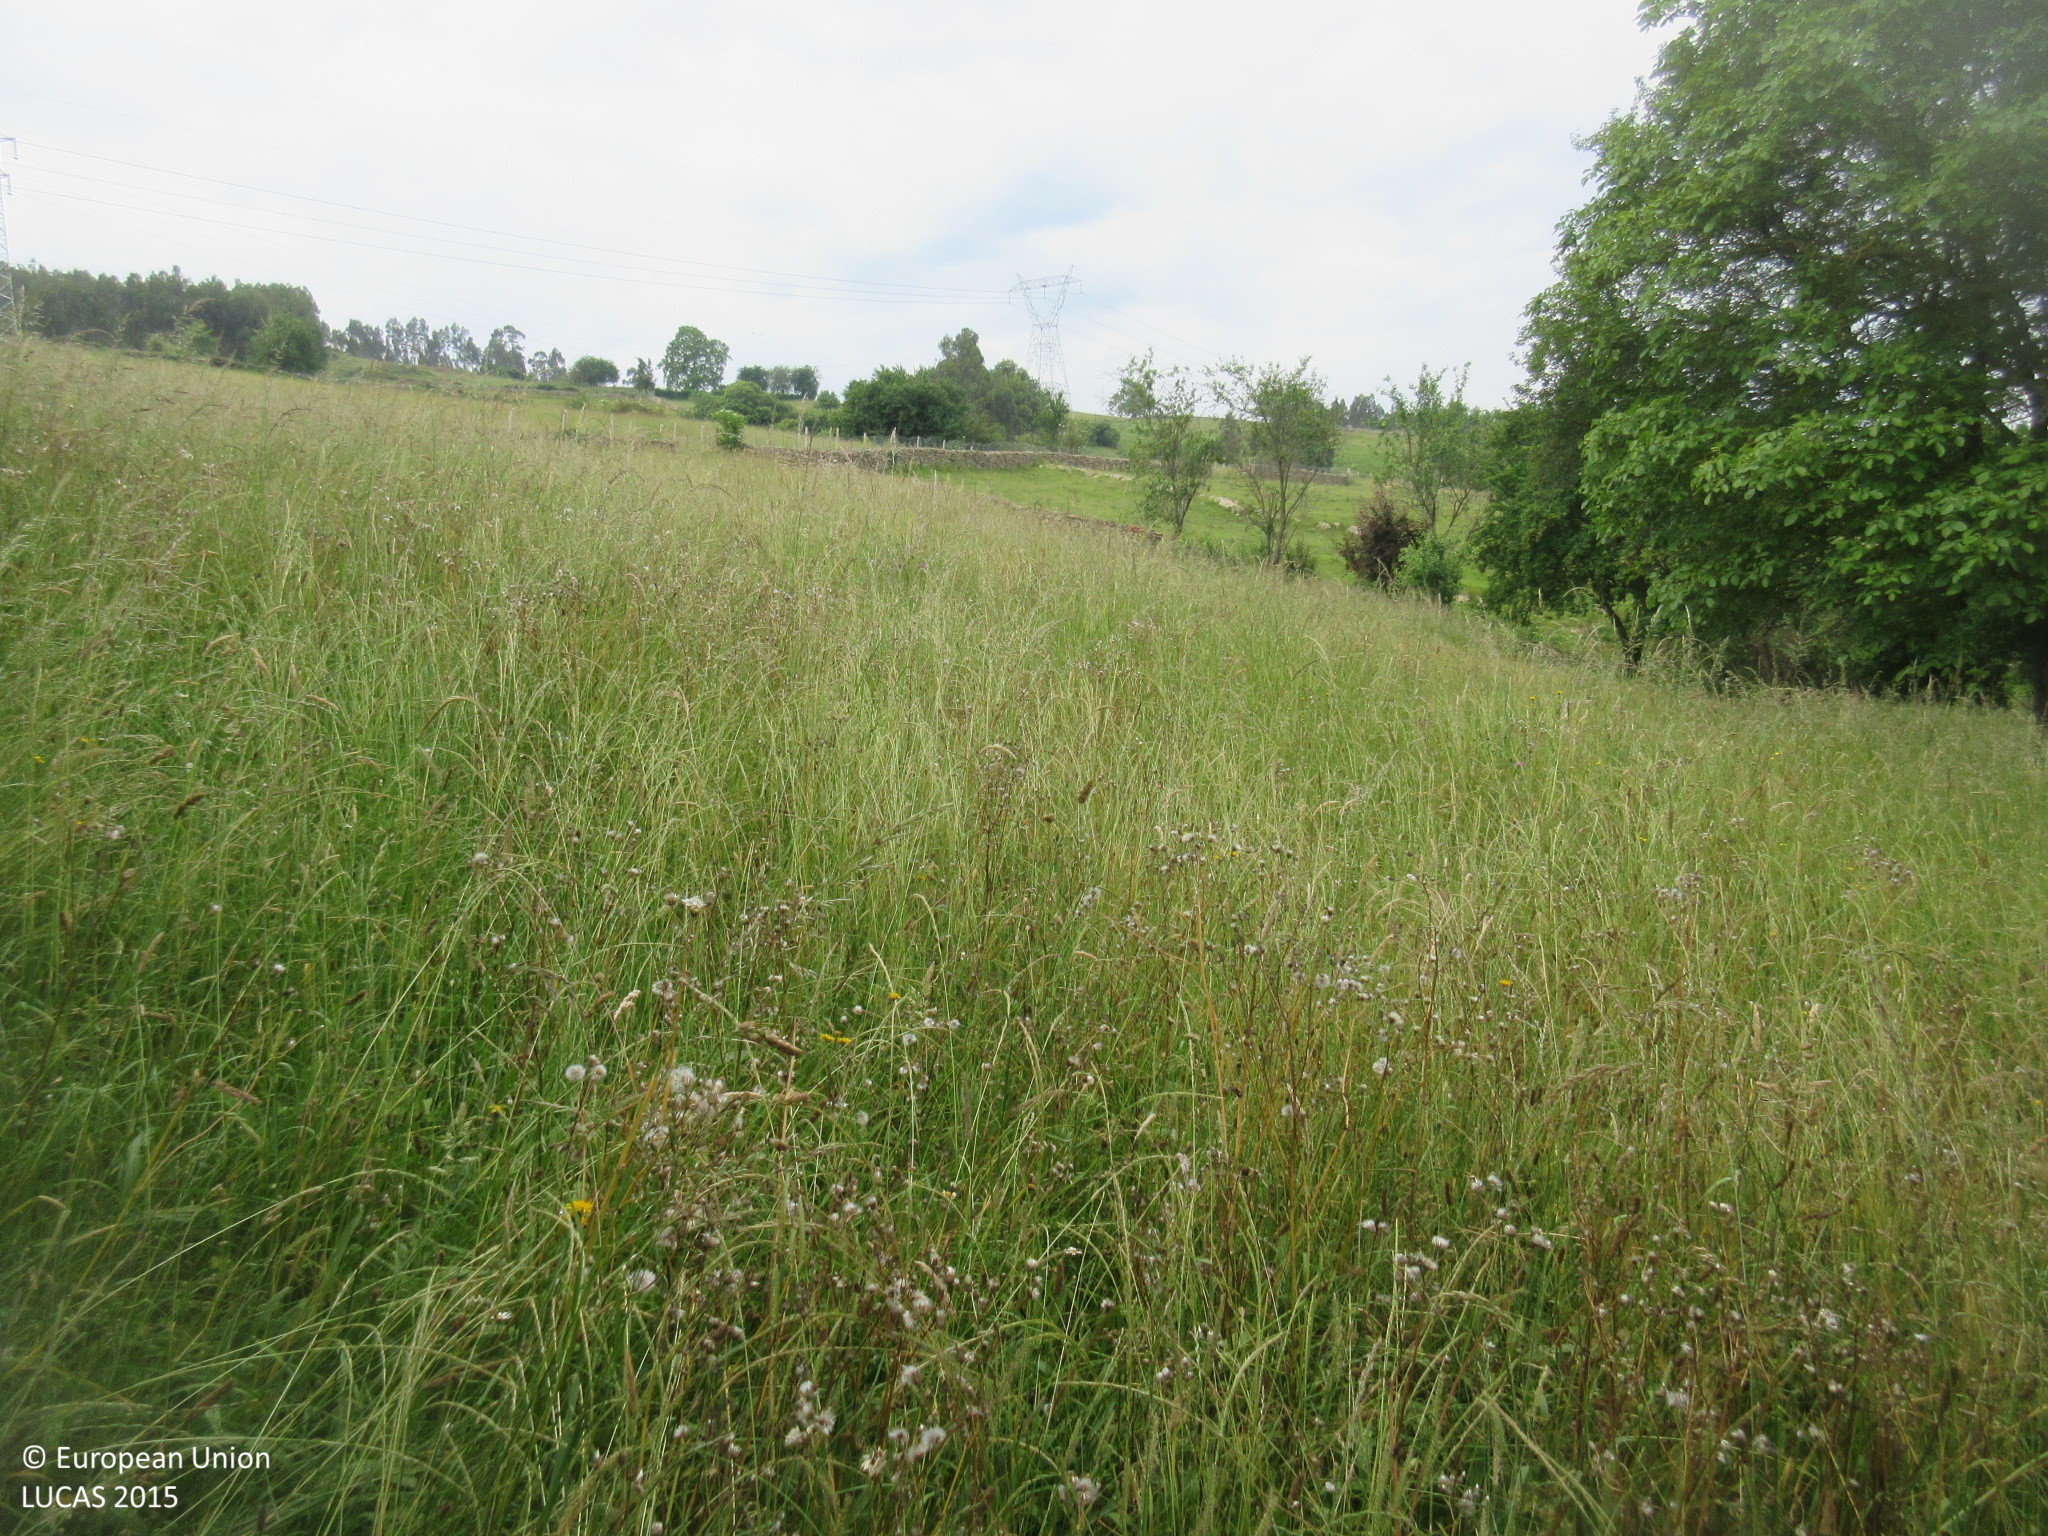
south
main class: Grassland
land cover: Grassland with sparse tree/shrub cover
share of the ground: > 75 %
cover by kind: herbaceous plants 95 %, broadleaved forest trees 5 %
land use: Agriculture (excluding fallow land and kitchen gardens)
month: June
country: ES
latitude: 43.3451
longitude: -4.1037
